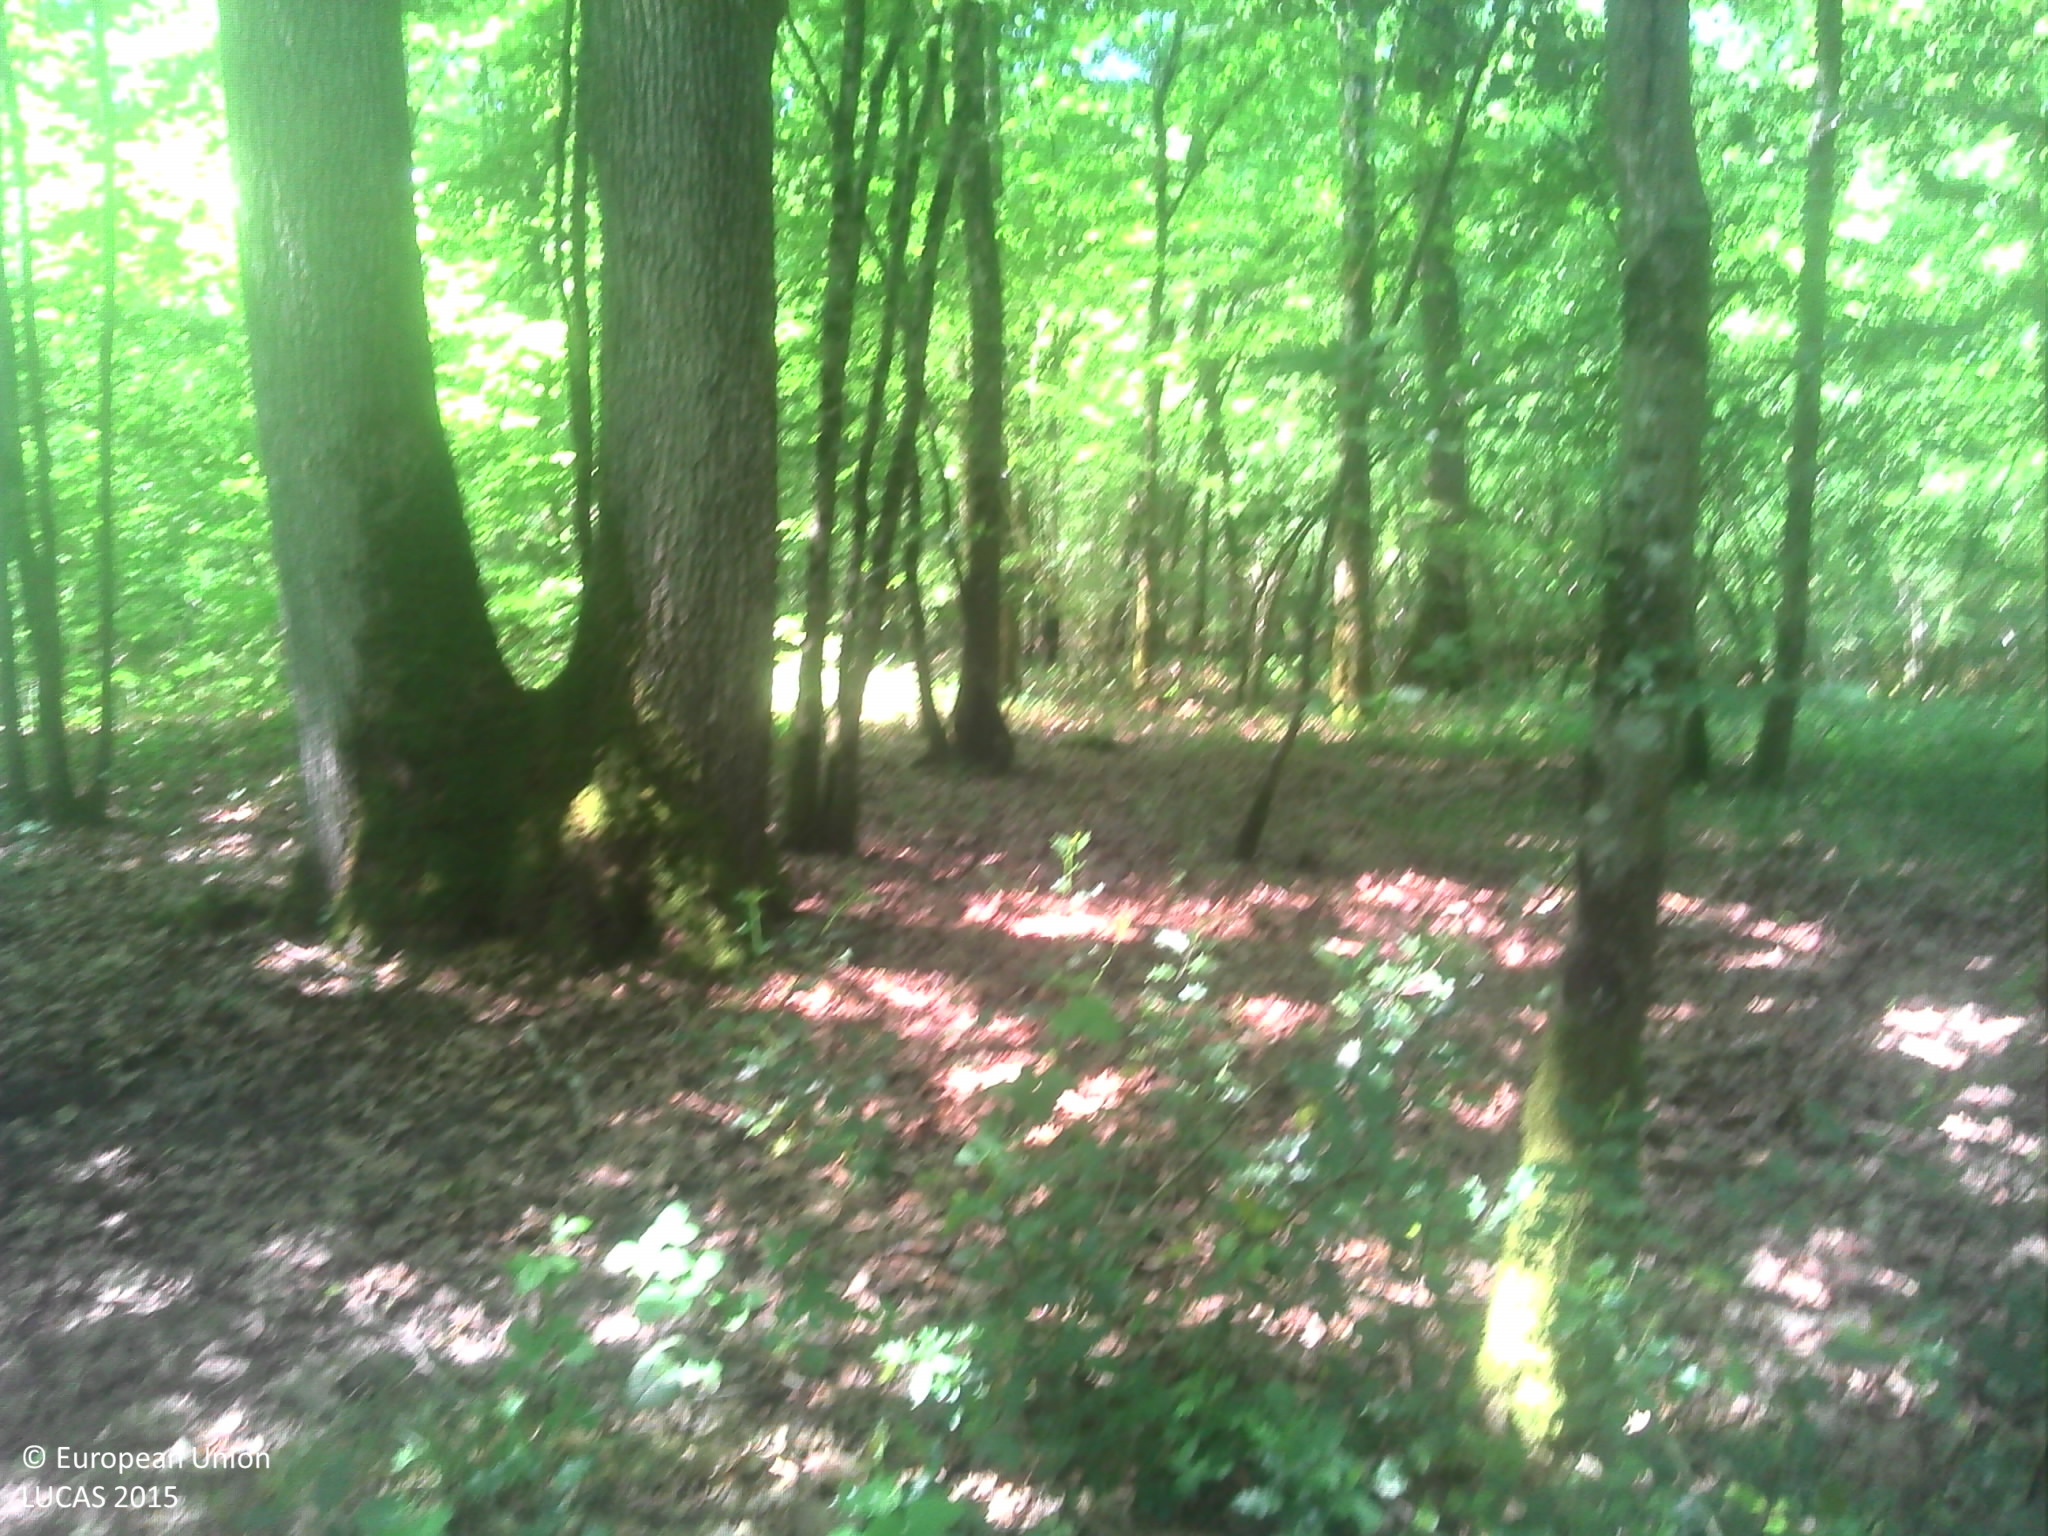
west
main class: Woodland
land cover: Broadleaved woodland
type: beech forest
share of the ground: > 75 %
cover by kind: broadleaved forest trees 90 %, herbaceous plants 10 %
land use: Forestry
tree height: > 5 m
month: June
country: FR
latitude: 48.4649
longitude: 4.8724
